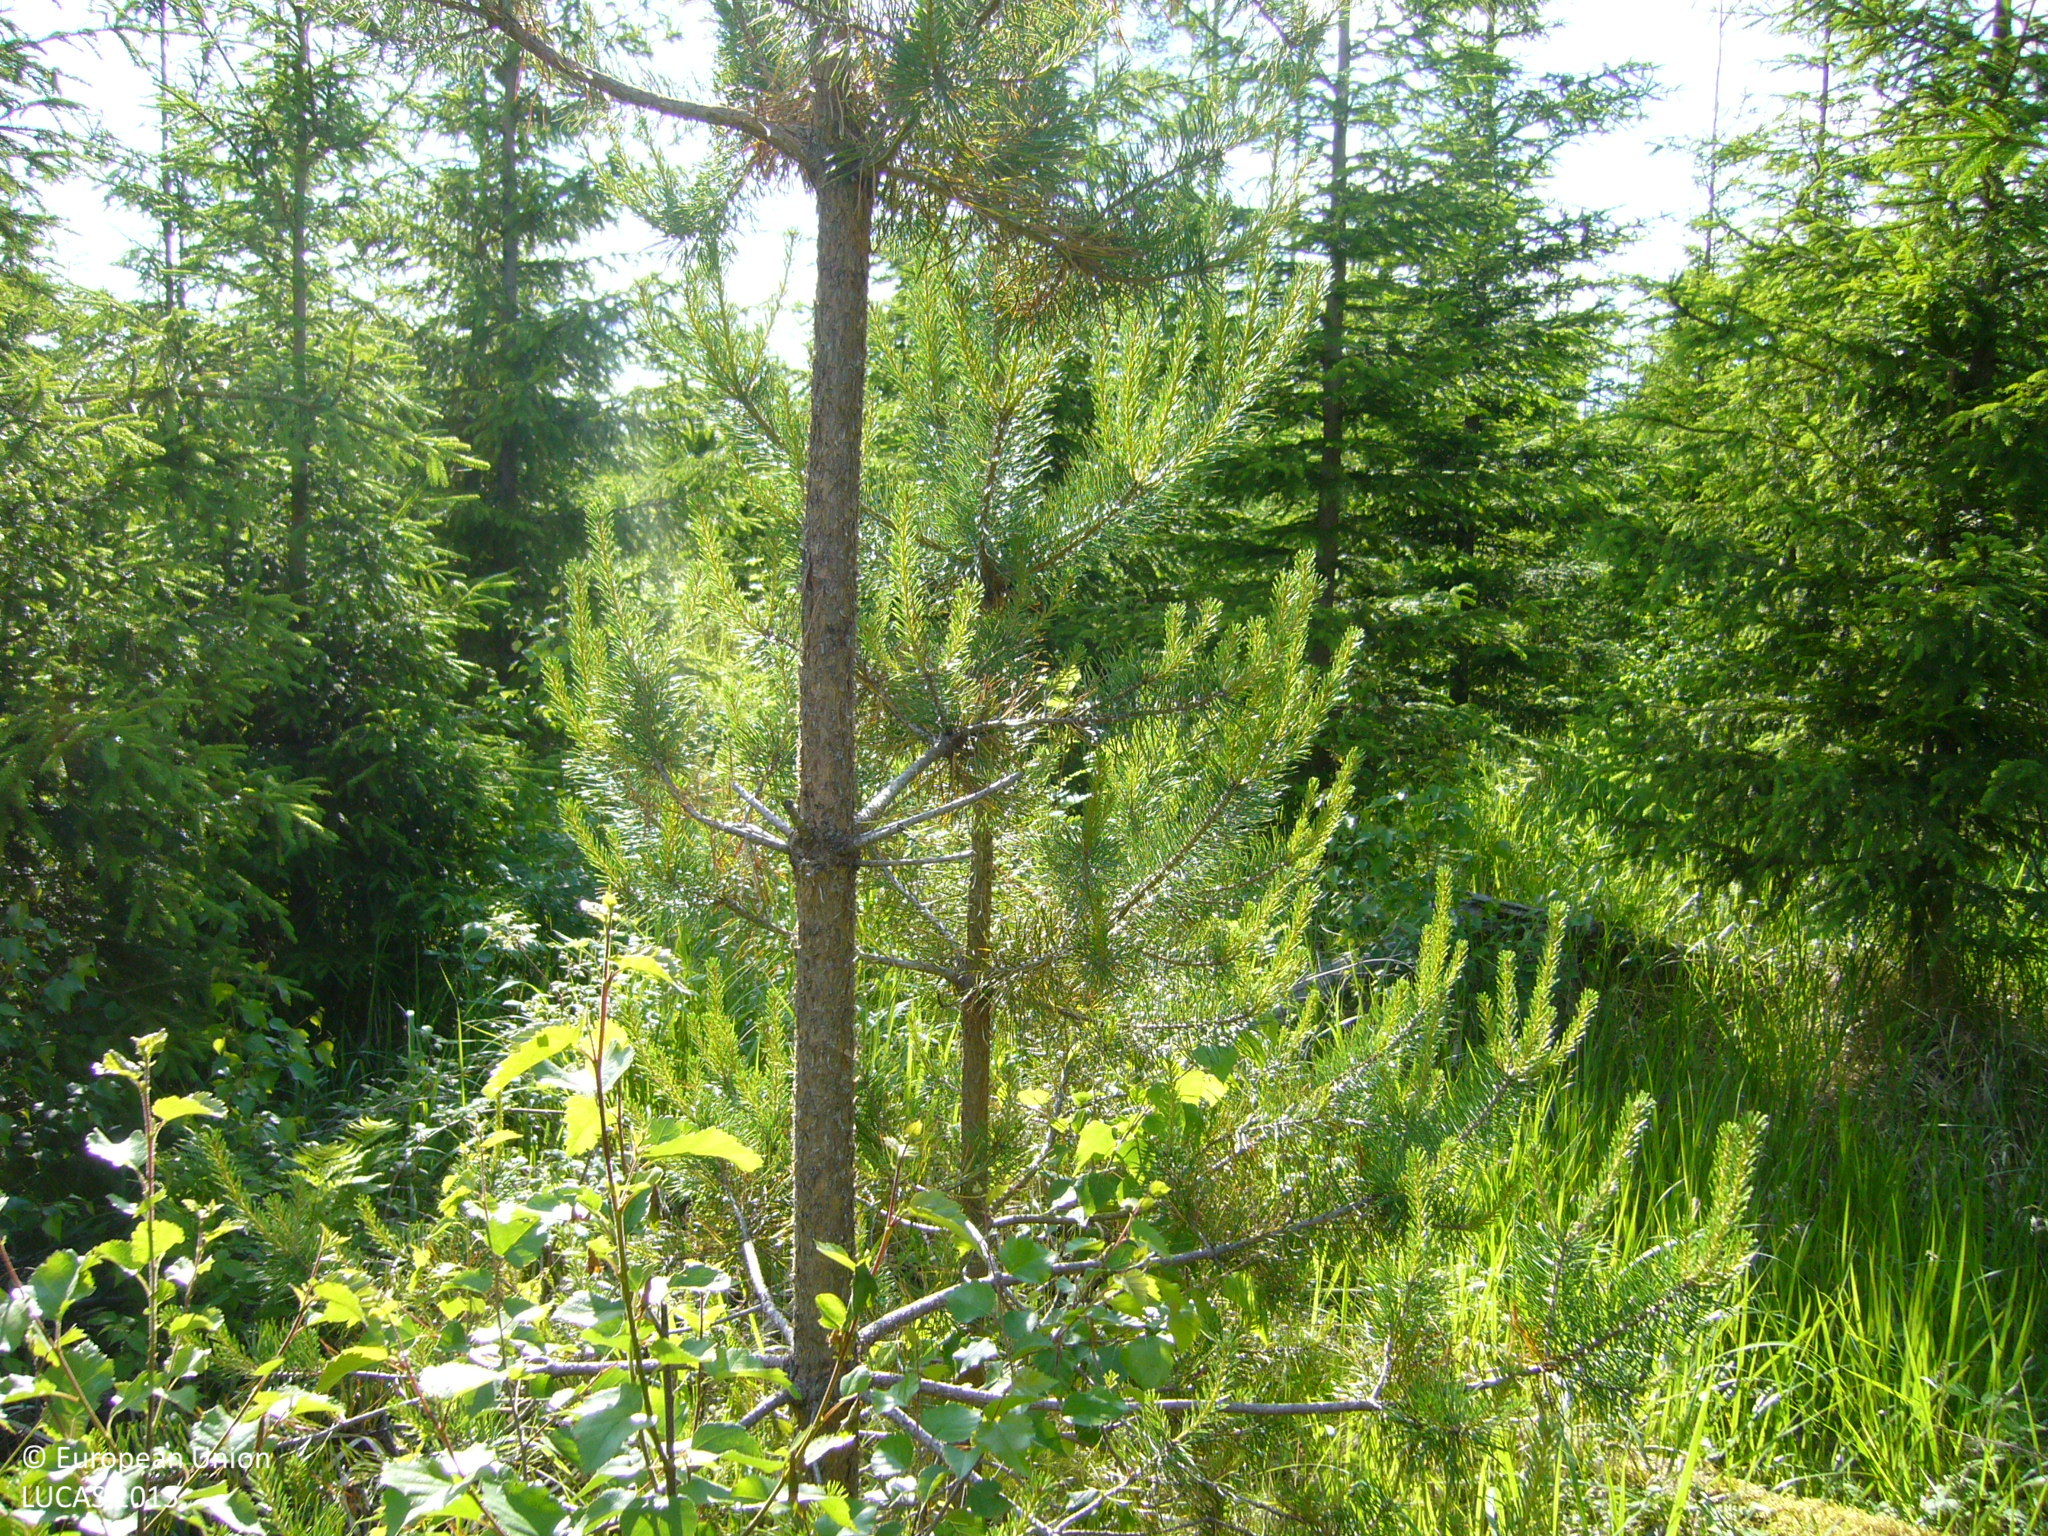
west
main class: Woodland
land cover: Spruce dominated coniferous woodland
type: boreal forest
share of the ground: 50 - 75 %
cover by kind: coniferous forest trees 50 %, shrubs 50 %
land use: Forestry
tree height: < 5 m
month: July
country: FI
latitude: 63.3825
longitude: 26.1020
